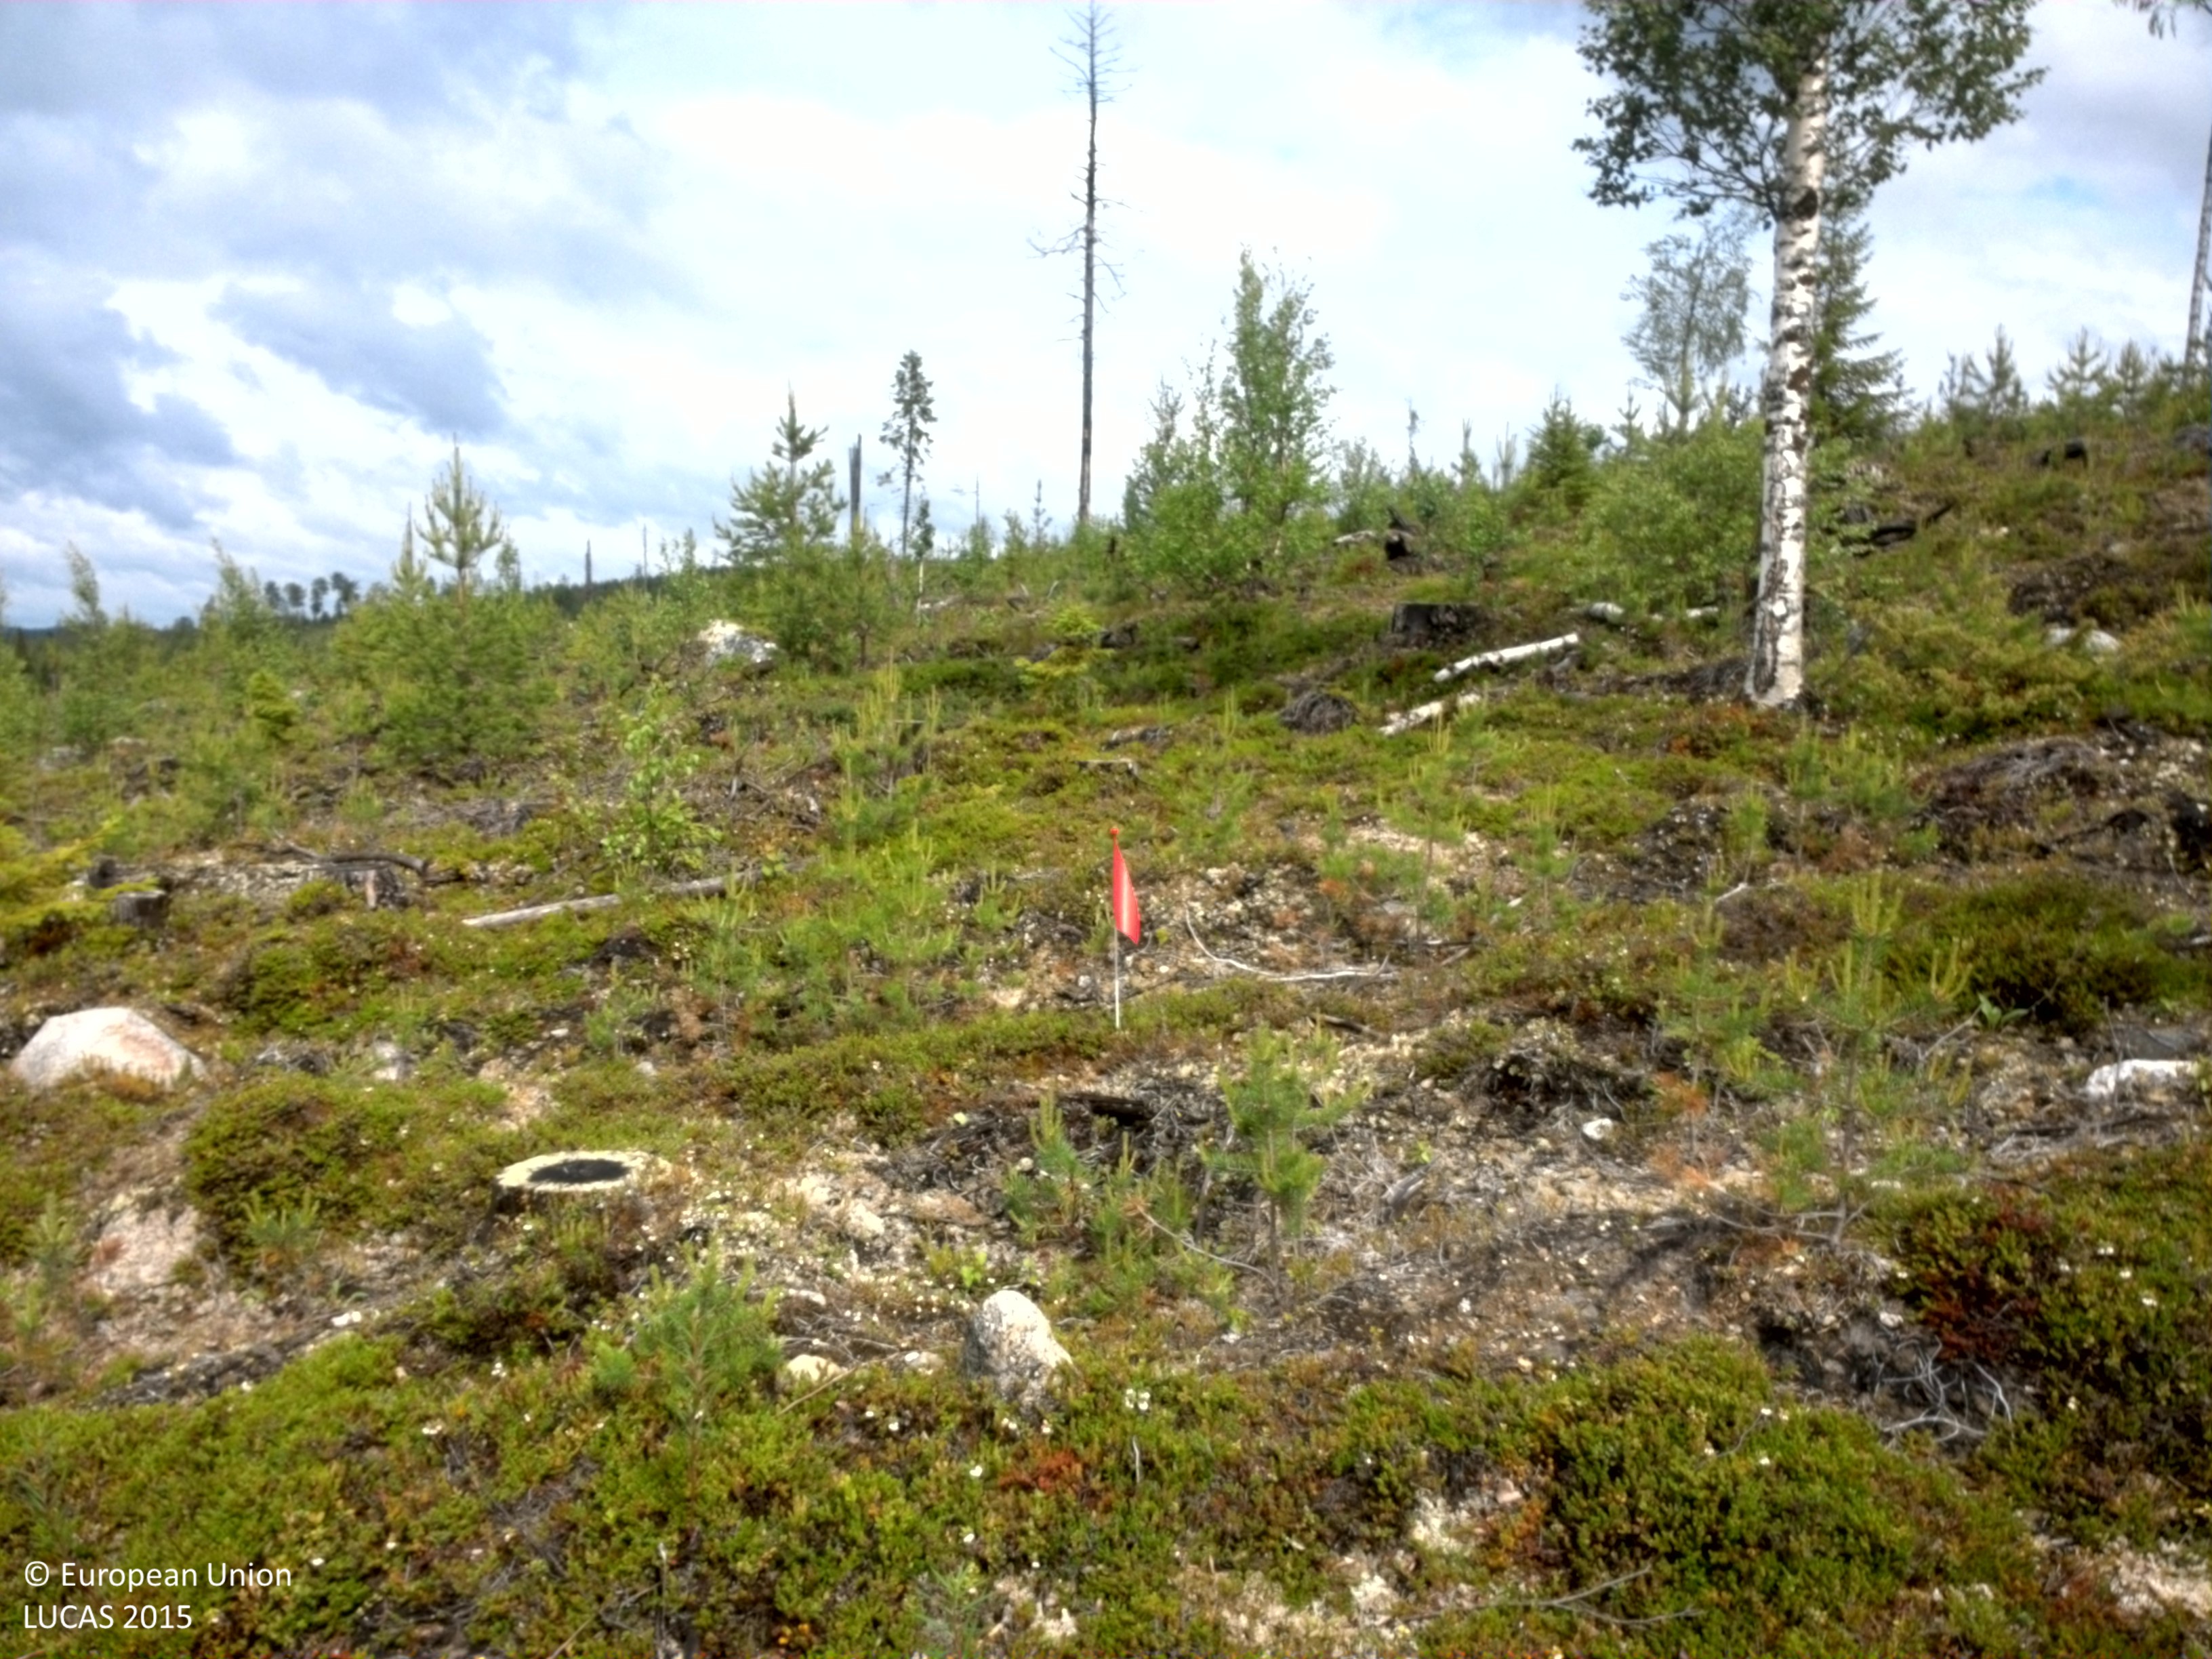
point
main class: Woodland
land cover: Pine dominated mixed woodland
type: boreal forest
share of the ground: 10 - 25 %
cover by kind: shrubs 50 %, lichens and mosses 30 %, coniferous forest trees 15 %, broadleaved forest trees 5 %
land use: Forestry
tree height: < 5 m
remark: Clear cut
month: July
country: SE
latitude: 64.6565
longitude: 18.2373
